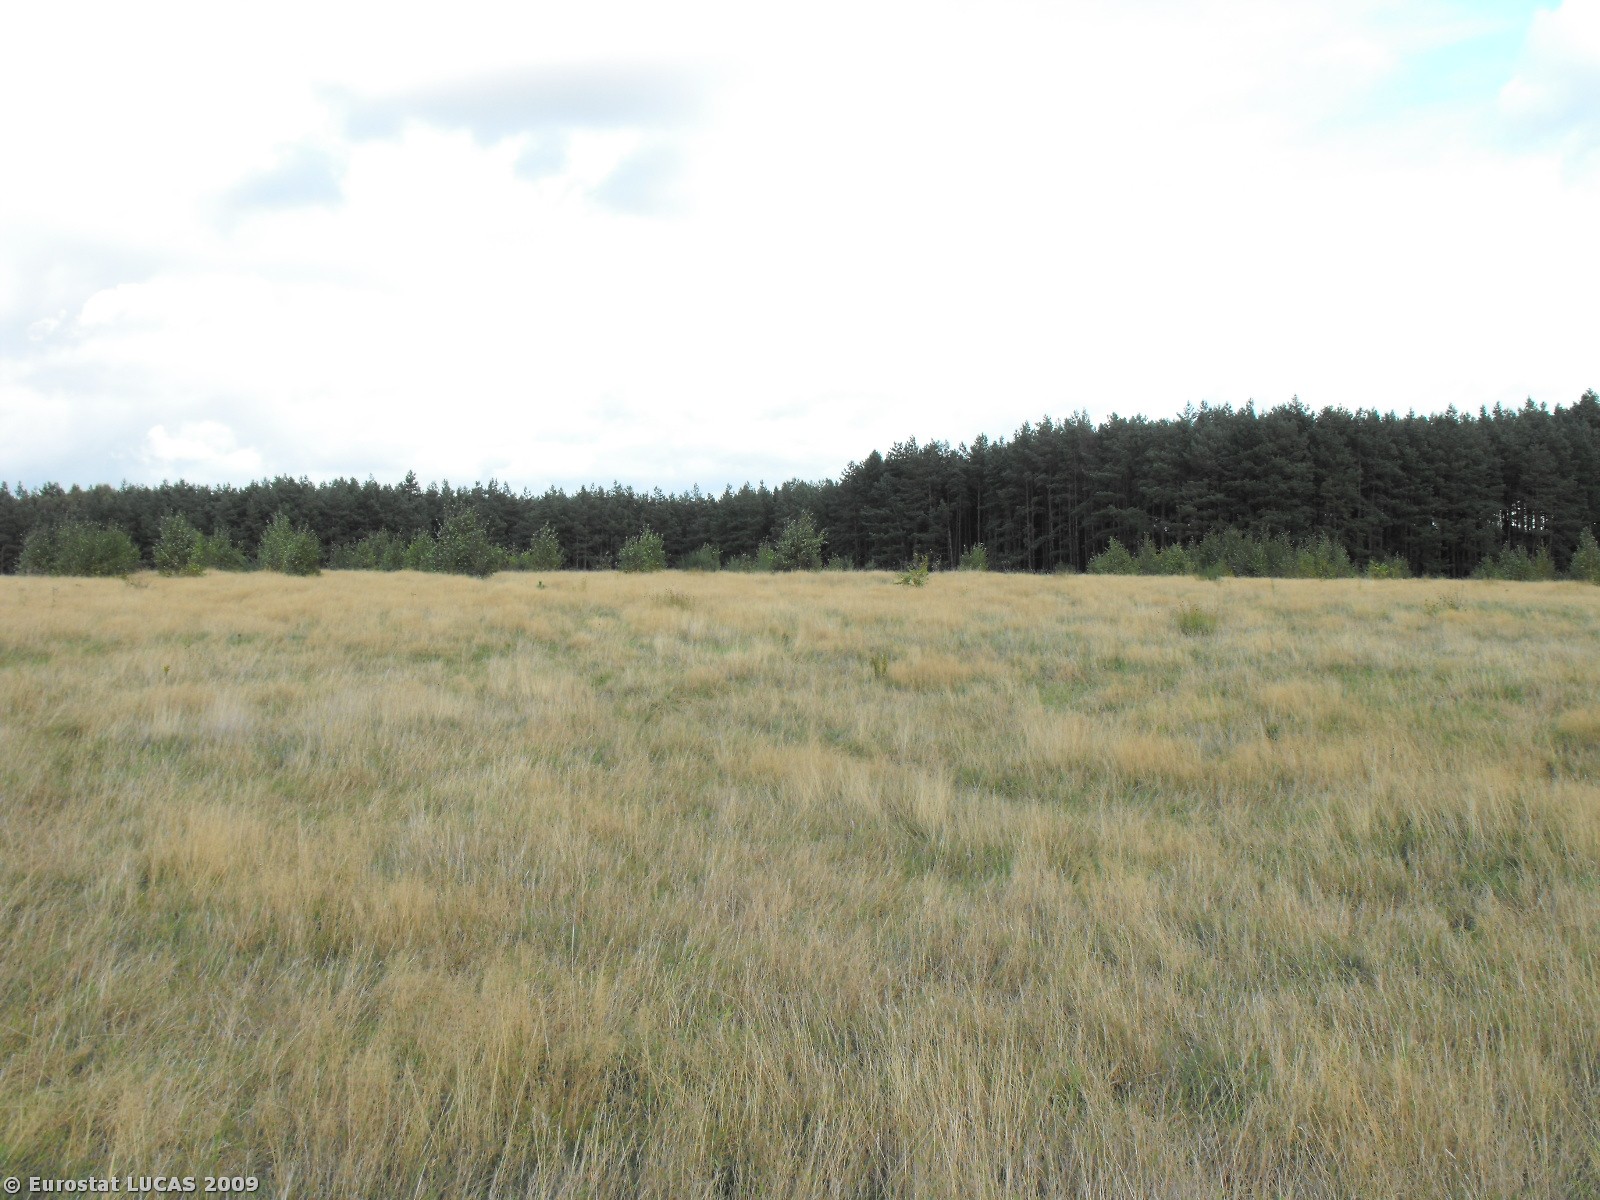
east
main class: Grassland
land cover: Grassland without tree/shrub cover
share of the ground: > 75 %
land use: Unused
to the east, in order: Grassland without tree/shrub cover; Grassland with sparse tree/shrub cover; Mixed woodland
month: September
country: PL
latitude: 54.2310
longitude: 16.6184
